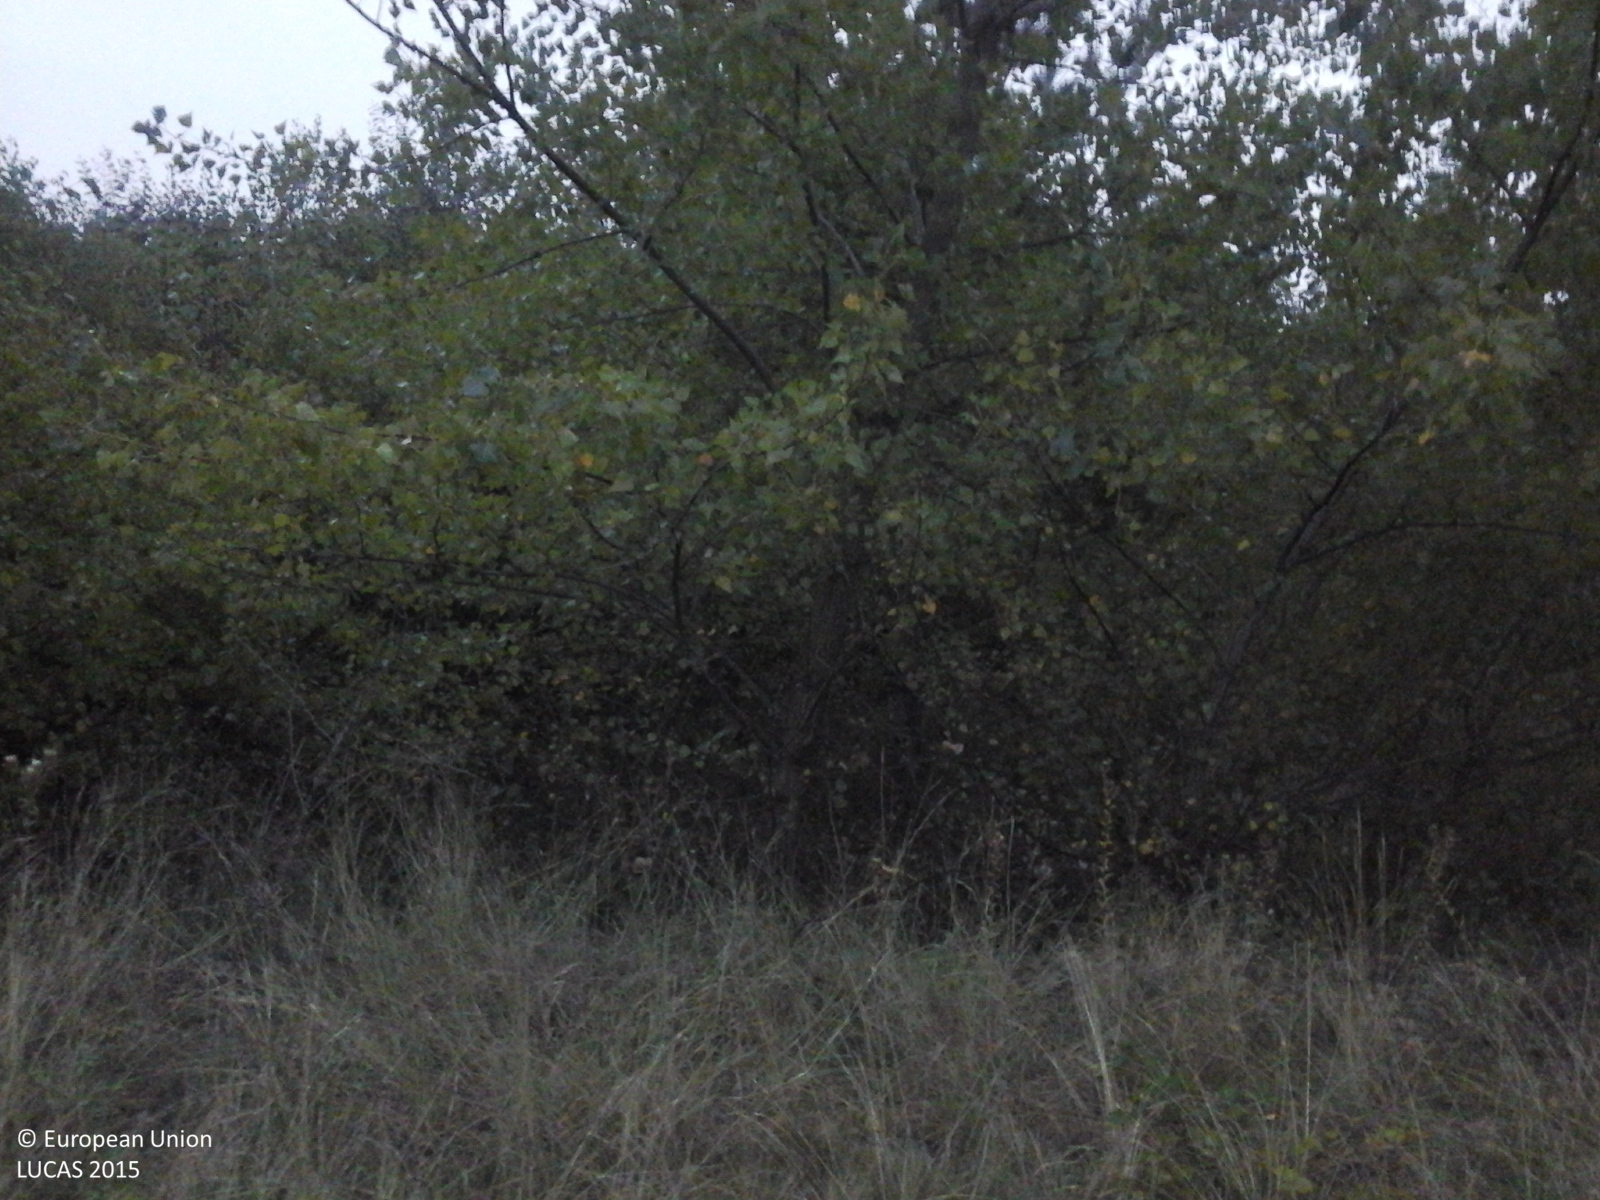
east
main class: Grassland
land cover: Spontaneously vegetated surfaces
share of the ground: > 75 %
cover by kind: herbaceous plants 60 %, consolidated bare surface 40 %
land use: Semi-natural and natural areas not in use
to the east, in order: Spontaneously vegetated surfaces; Shrubland with sparse tree cover; Paved roads, cycling and walking lanes; Abandoned hedges; Spontaneously vegetated surfaces; Railways; Grass margins; Ditches and canals; Abandoned hedges; Grassland without tree/shrub cover
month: September
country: RO
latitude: 45.1422
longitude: 23.3713
